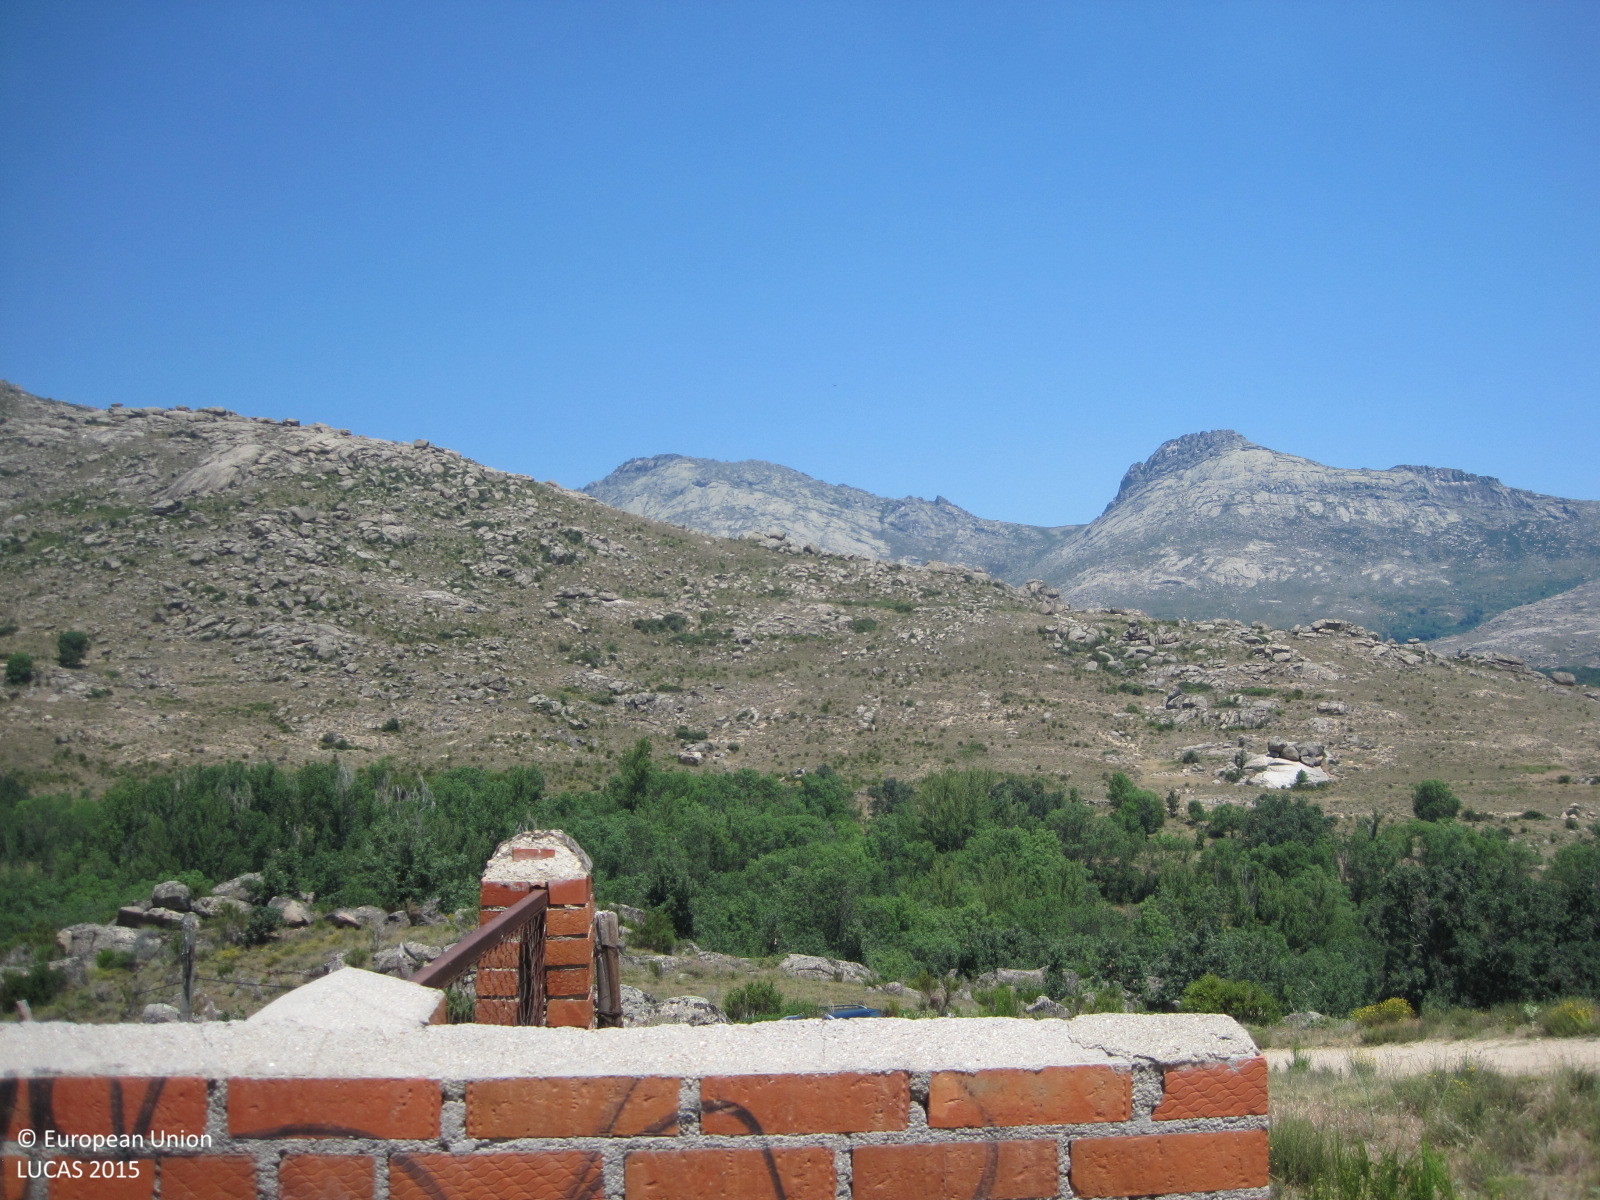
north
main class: Woodland
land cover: Pine dominated coniferous woodland
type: coniferous forest of the mediterranean region
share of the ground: > 75 %
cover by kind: coniferous forest trees 95 %, herbaceous plants 5 %
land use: Forestry
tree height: > 5 m
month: June
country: ES
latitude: 40.4478
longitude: -4.8764
